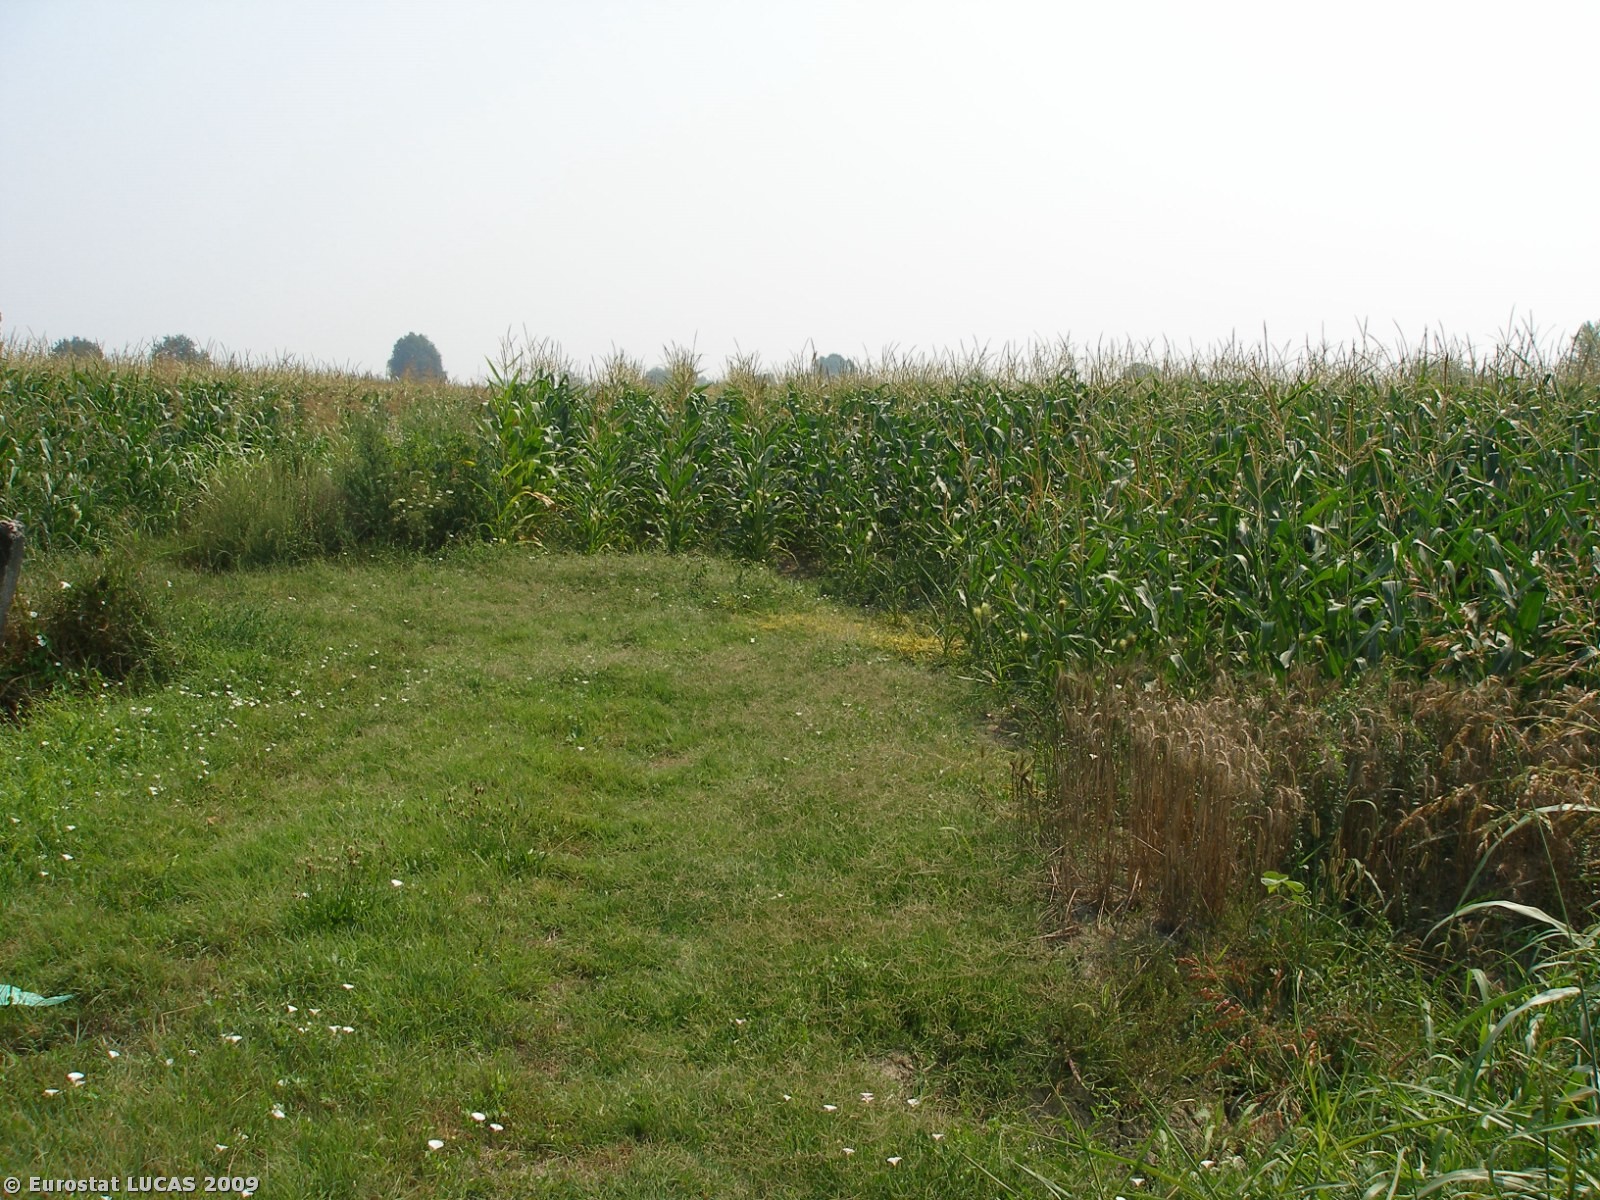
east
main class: Cropland
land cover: Maize
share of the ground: > 75 %
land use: Agriculture (excluding fallow land and kitchen gardens)
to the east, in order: Maize; Ditches and canals; Maize; Ditches and canals; Arable land (only in case pi); Ditches and canals; Managed hedges; Grassland without tree/shrub cover
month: July
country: IT
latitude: 44.9317
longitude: 11.7073
